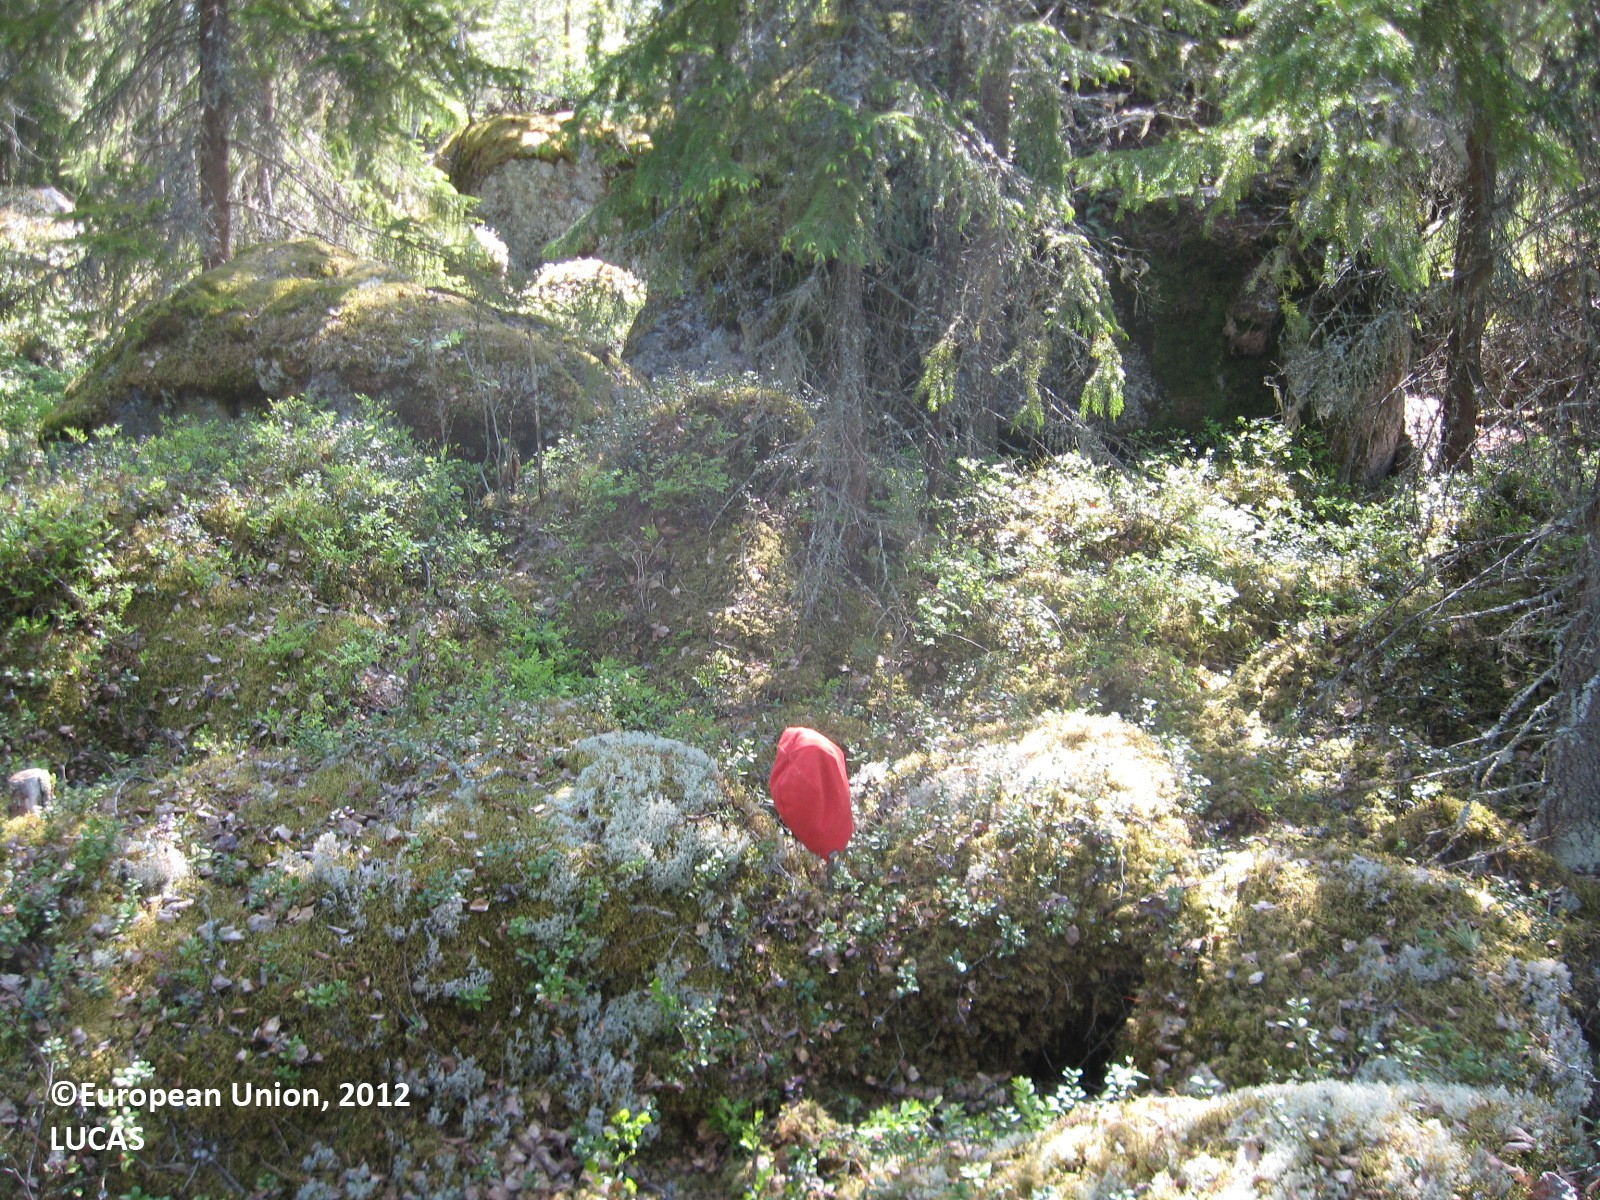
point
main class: Woodland
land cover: Spruce dominated coniferous woodland
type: boreal forest
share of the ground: 50 - 75 %
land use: Forestry
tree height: > 5 m
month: June
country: FI
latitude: 63.1569
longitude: 21.7326
